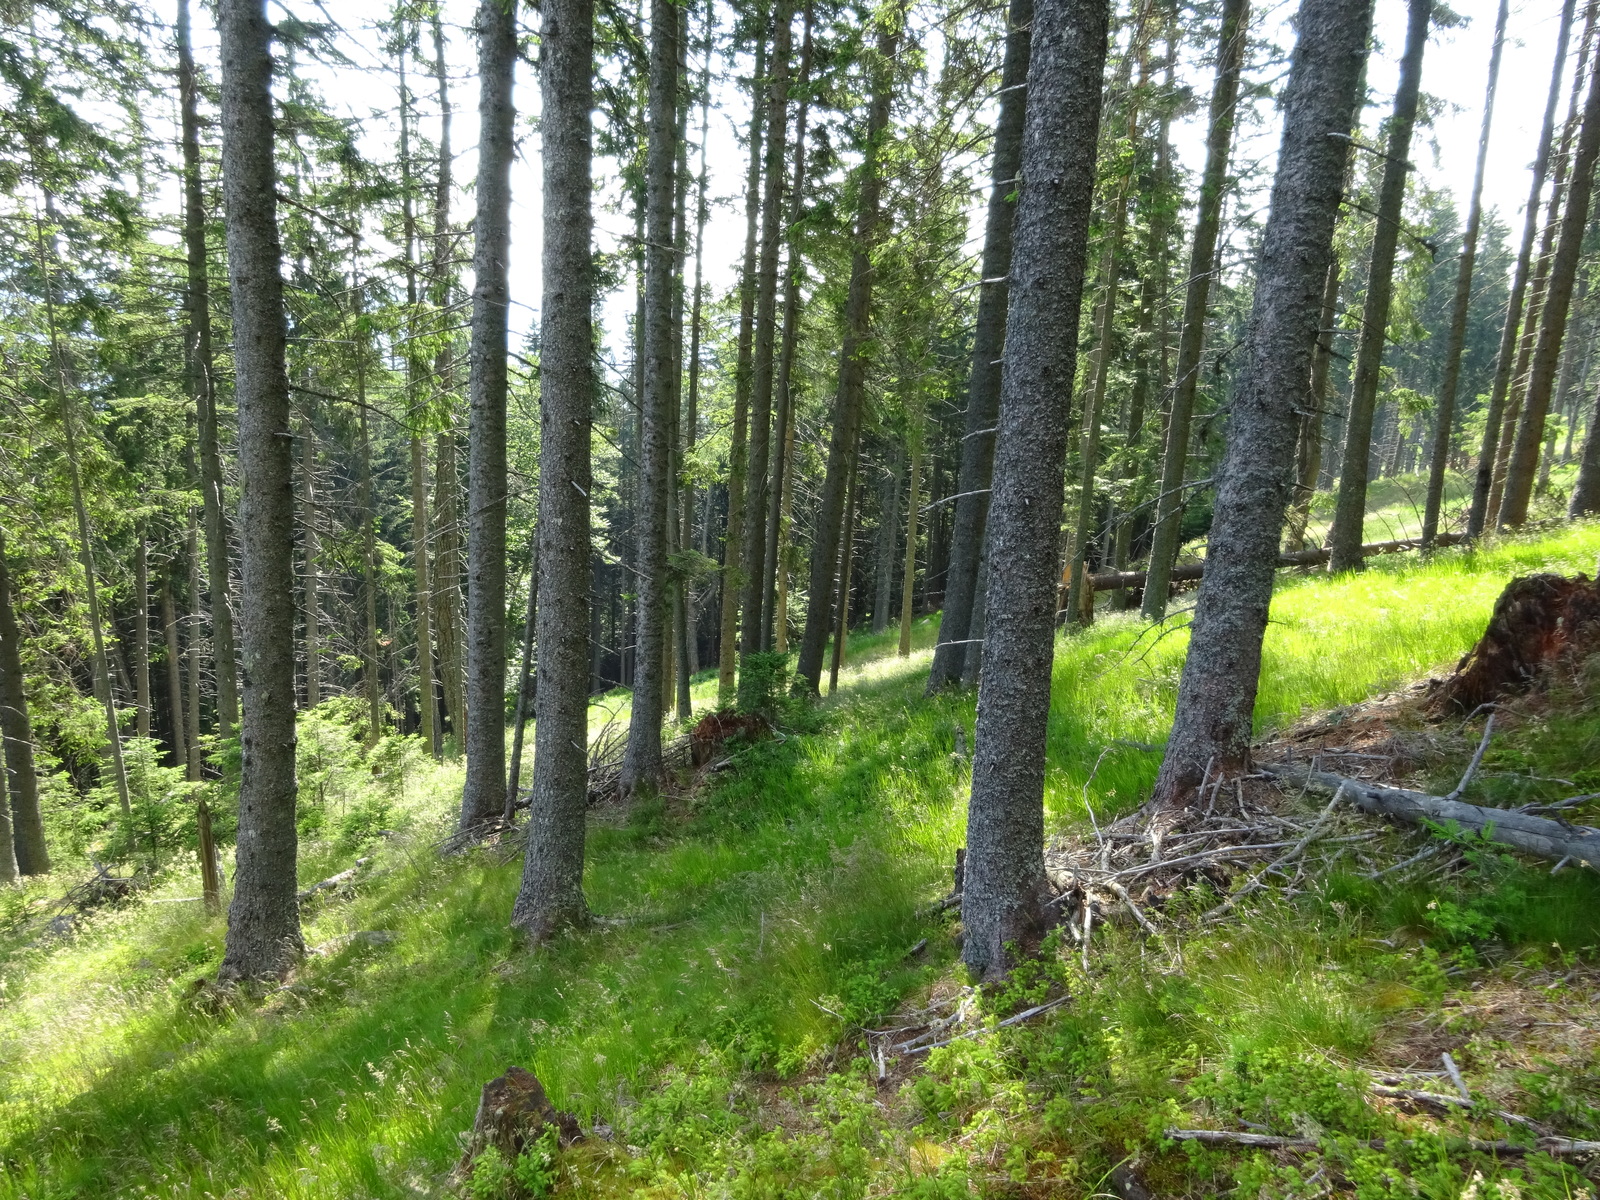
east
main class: Grassland
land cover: Grassland with sparse tree/shrub cover
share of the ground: > 75 %
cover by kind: herbaceous plants 95 %, coniferous forest trees 5 %
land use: Forestry
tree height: < 5 m
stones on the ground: < 10 %
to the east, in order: Grassland with sparse tree/shrub cover; Spruce dominated coniferous woodland; Tracks; Spruce dominated coniferous woodland; Tracks; Spruce dominated mixed woodland; Spruce dominated coniferous woodland
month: July
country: AT
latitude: 47.0324
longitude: 14.9072
